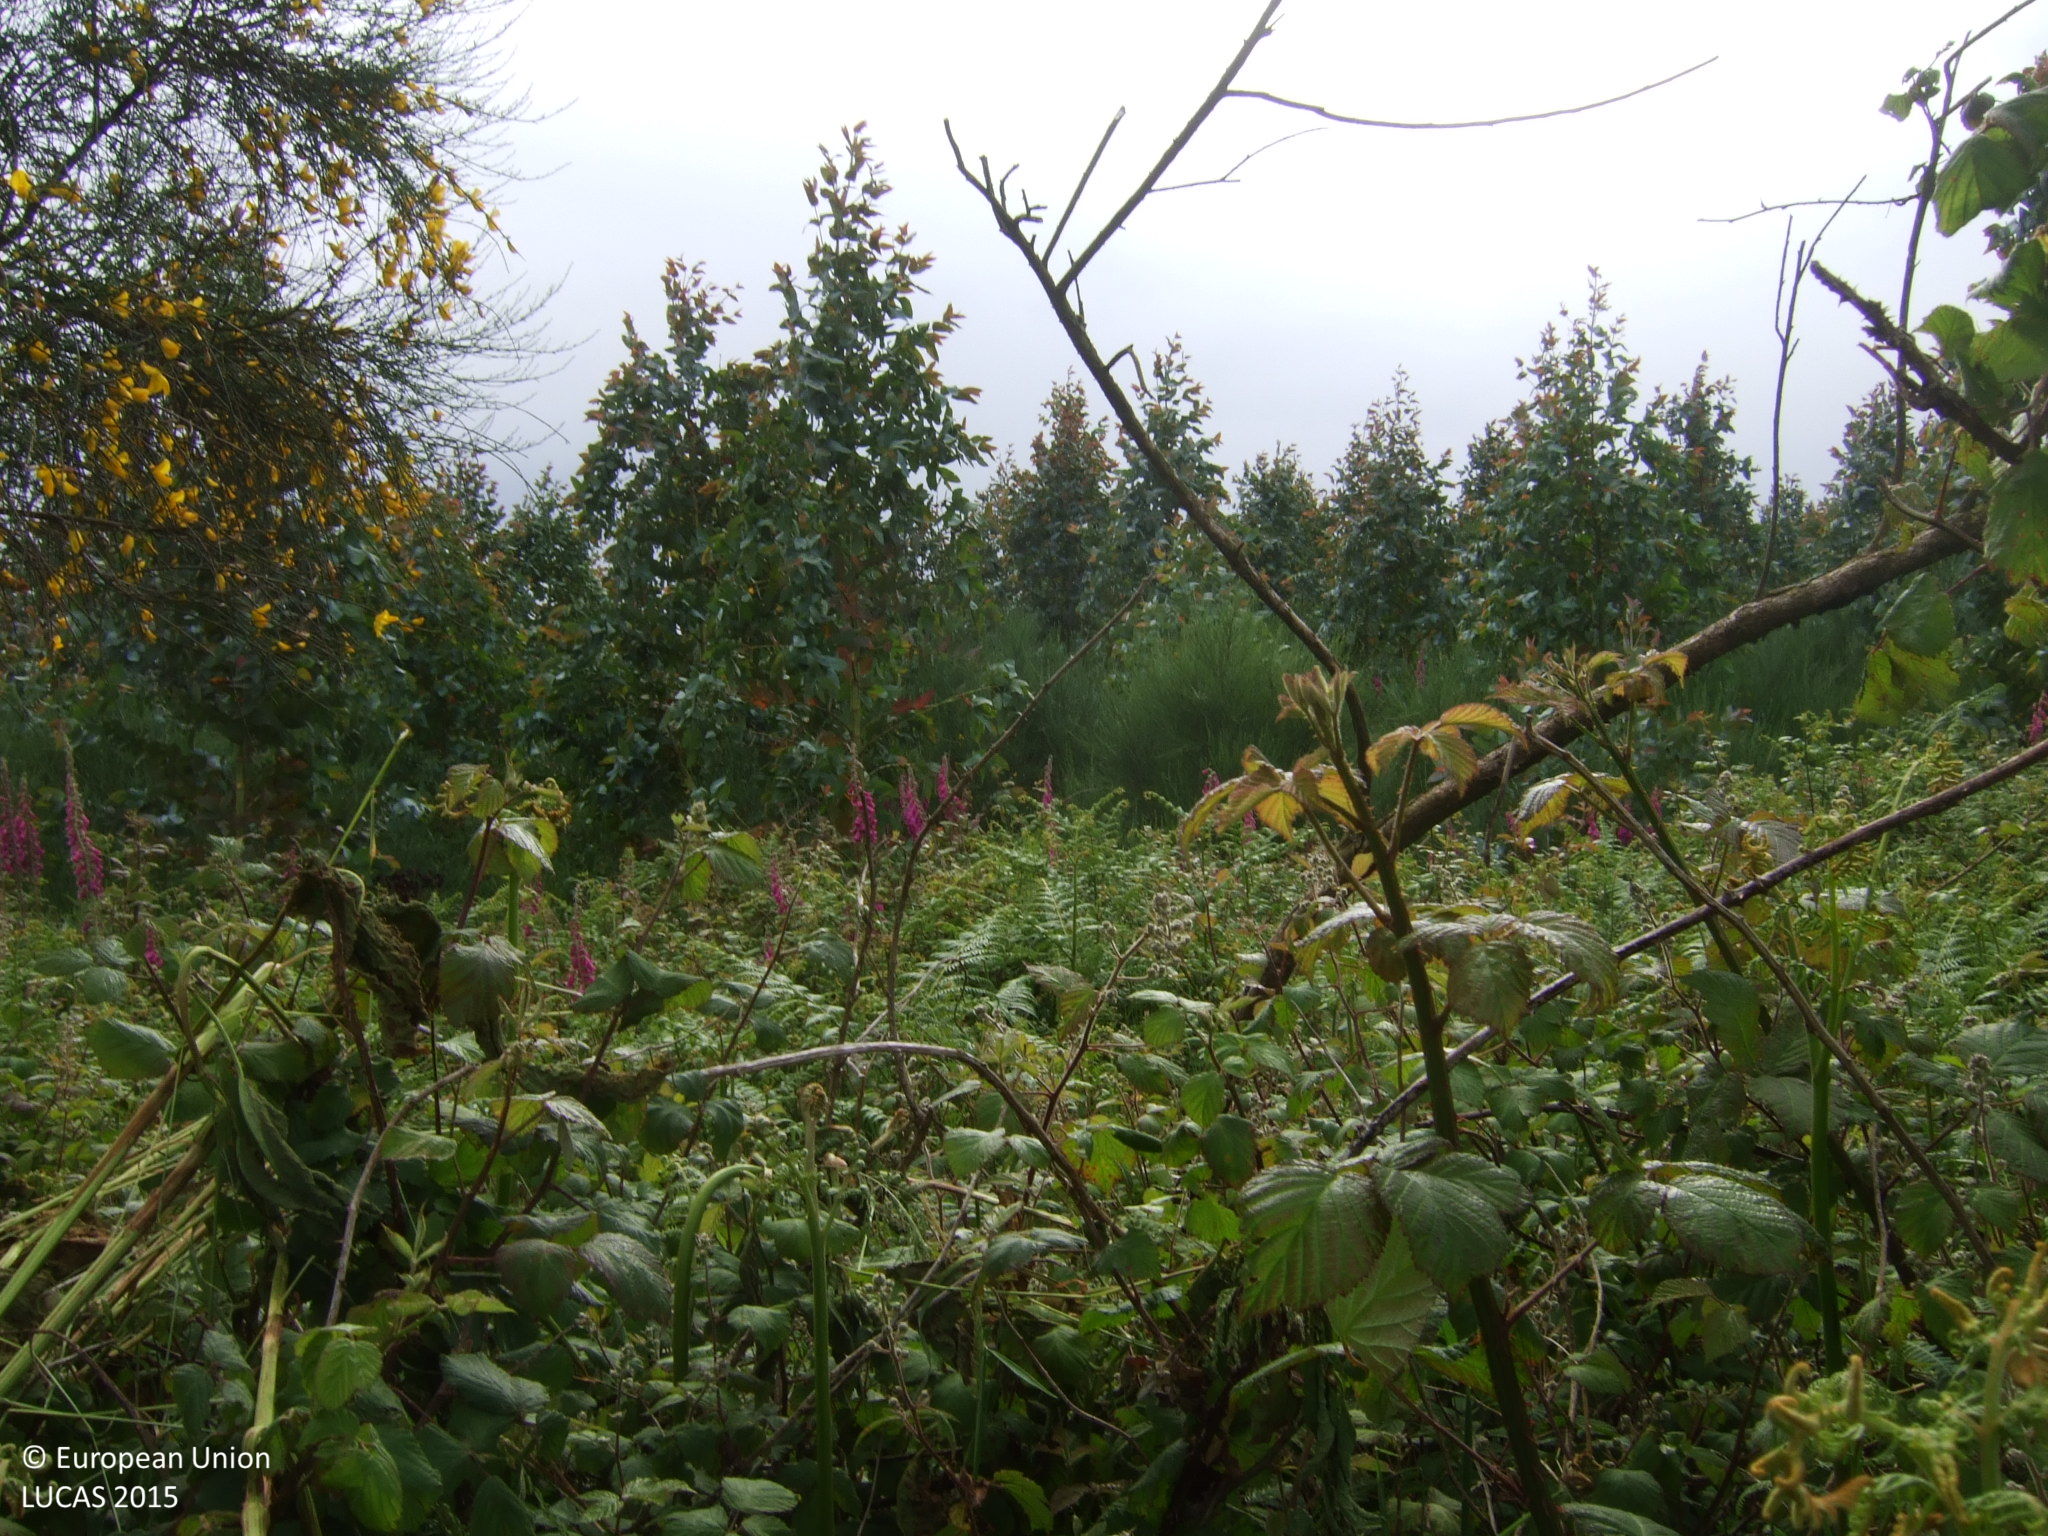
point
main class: Woodland
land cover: Broadleaved woodland
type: exotic forest
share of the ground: 25 - 50 %
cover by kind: shrubs 70 %, broadleaved forest trees 30 %
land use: Forestry
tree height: < 5 m
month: June
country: ES
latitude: 43.4098
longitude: -7.4544
